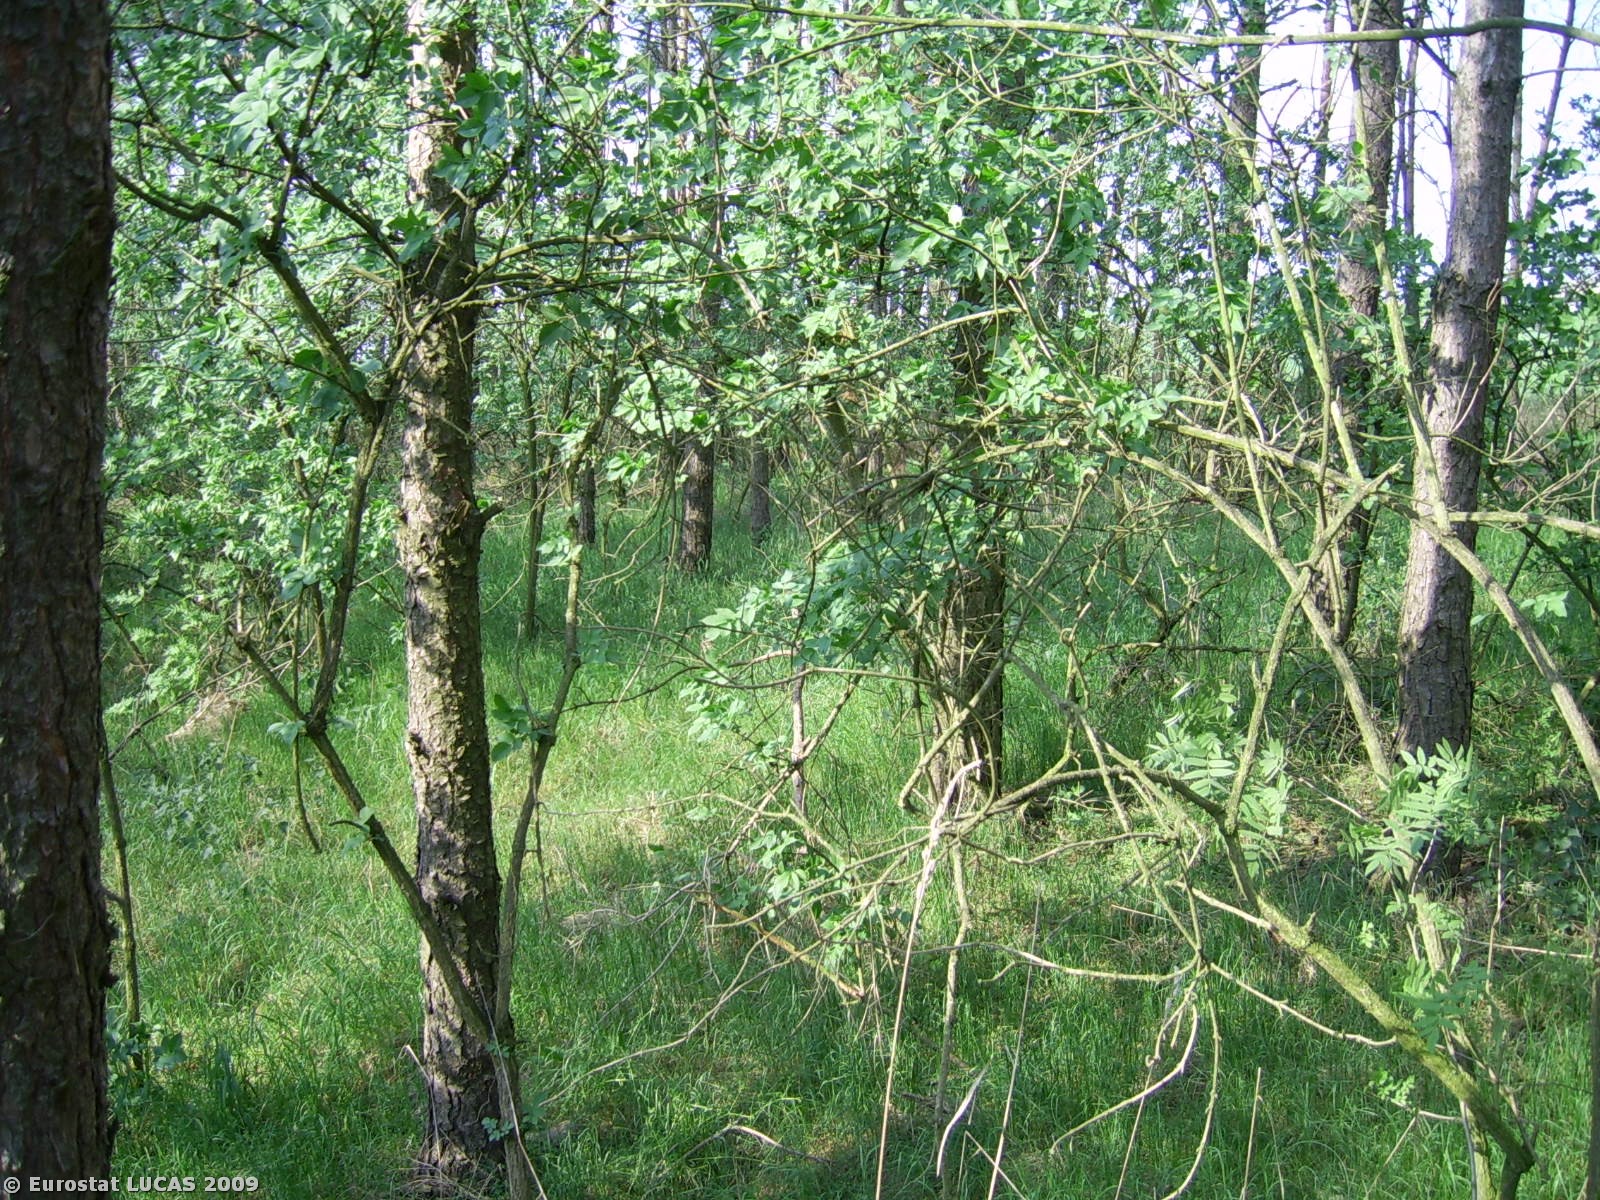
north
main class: Woodland
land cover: Coniferous woodland
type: hemiboreal forest and nemoral coniferous forest and mixed broadleaved-coniferous forest
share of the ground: > 75 %
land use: Forestry
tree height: > 5 m
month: April
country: PL
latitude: 51.9785
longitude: 16.8958
